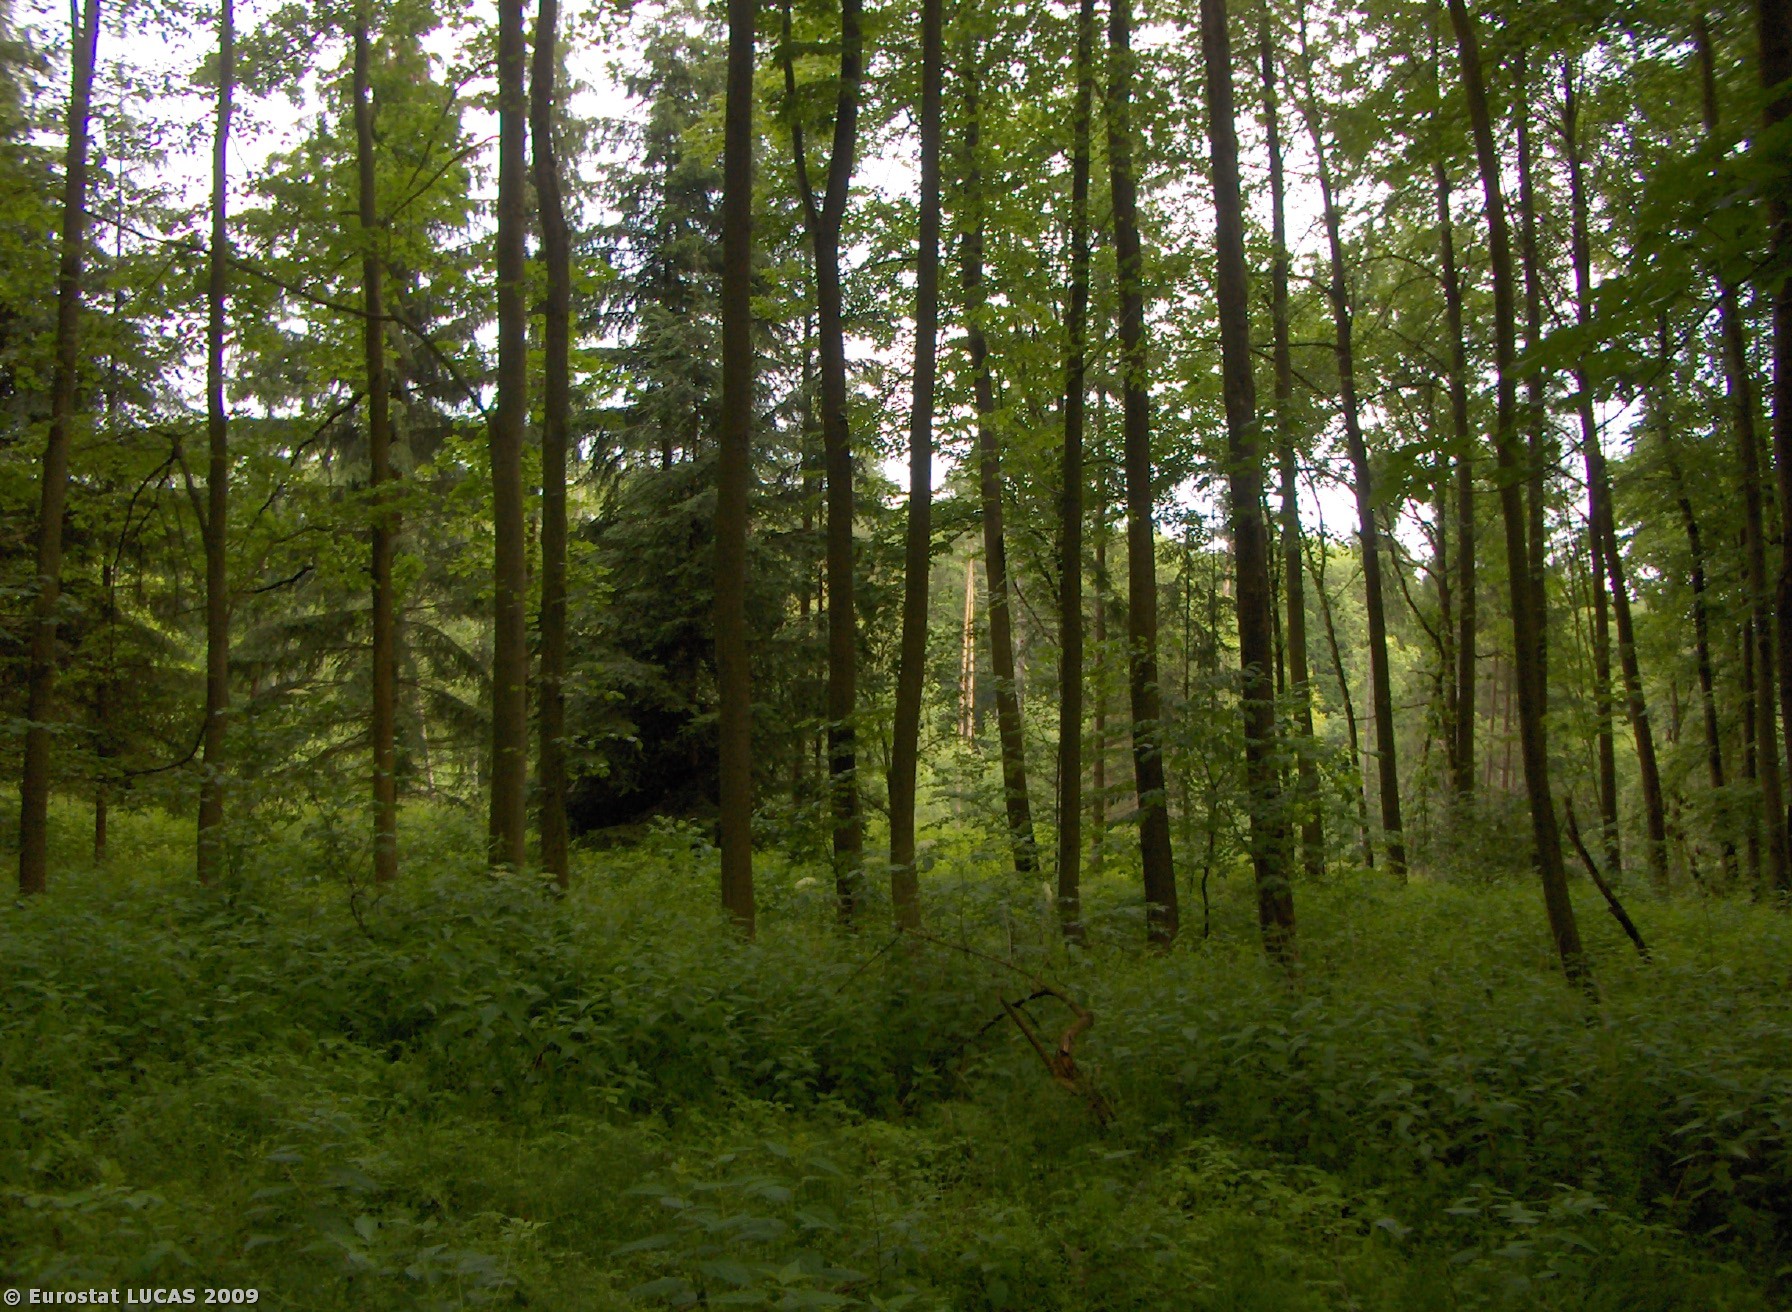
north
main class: Woodland
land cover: Broadleaved woodland
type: mesophytic deciduous forest
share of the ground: > 75 %
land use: Forestry
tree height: > 5 m
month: June
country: CZ
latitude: 49.0453
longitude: 14.1735
